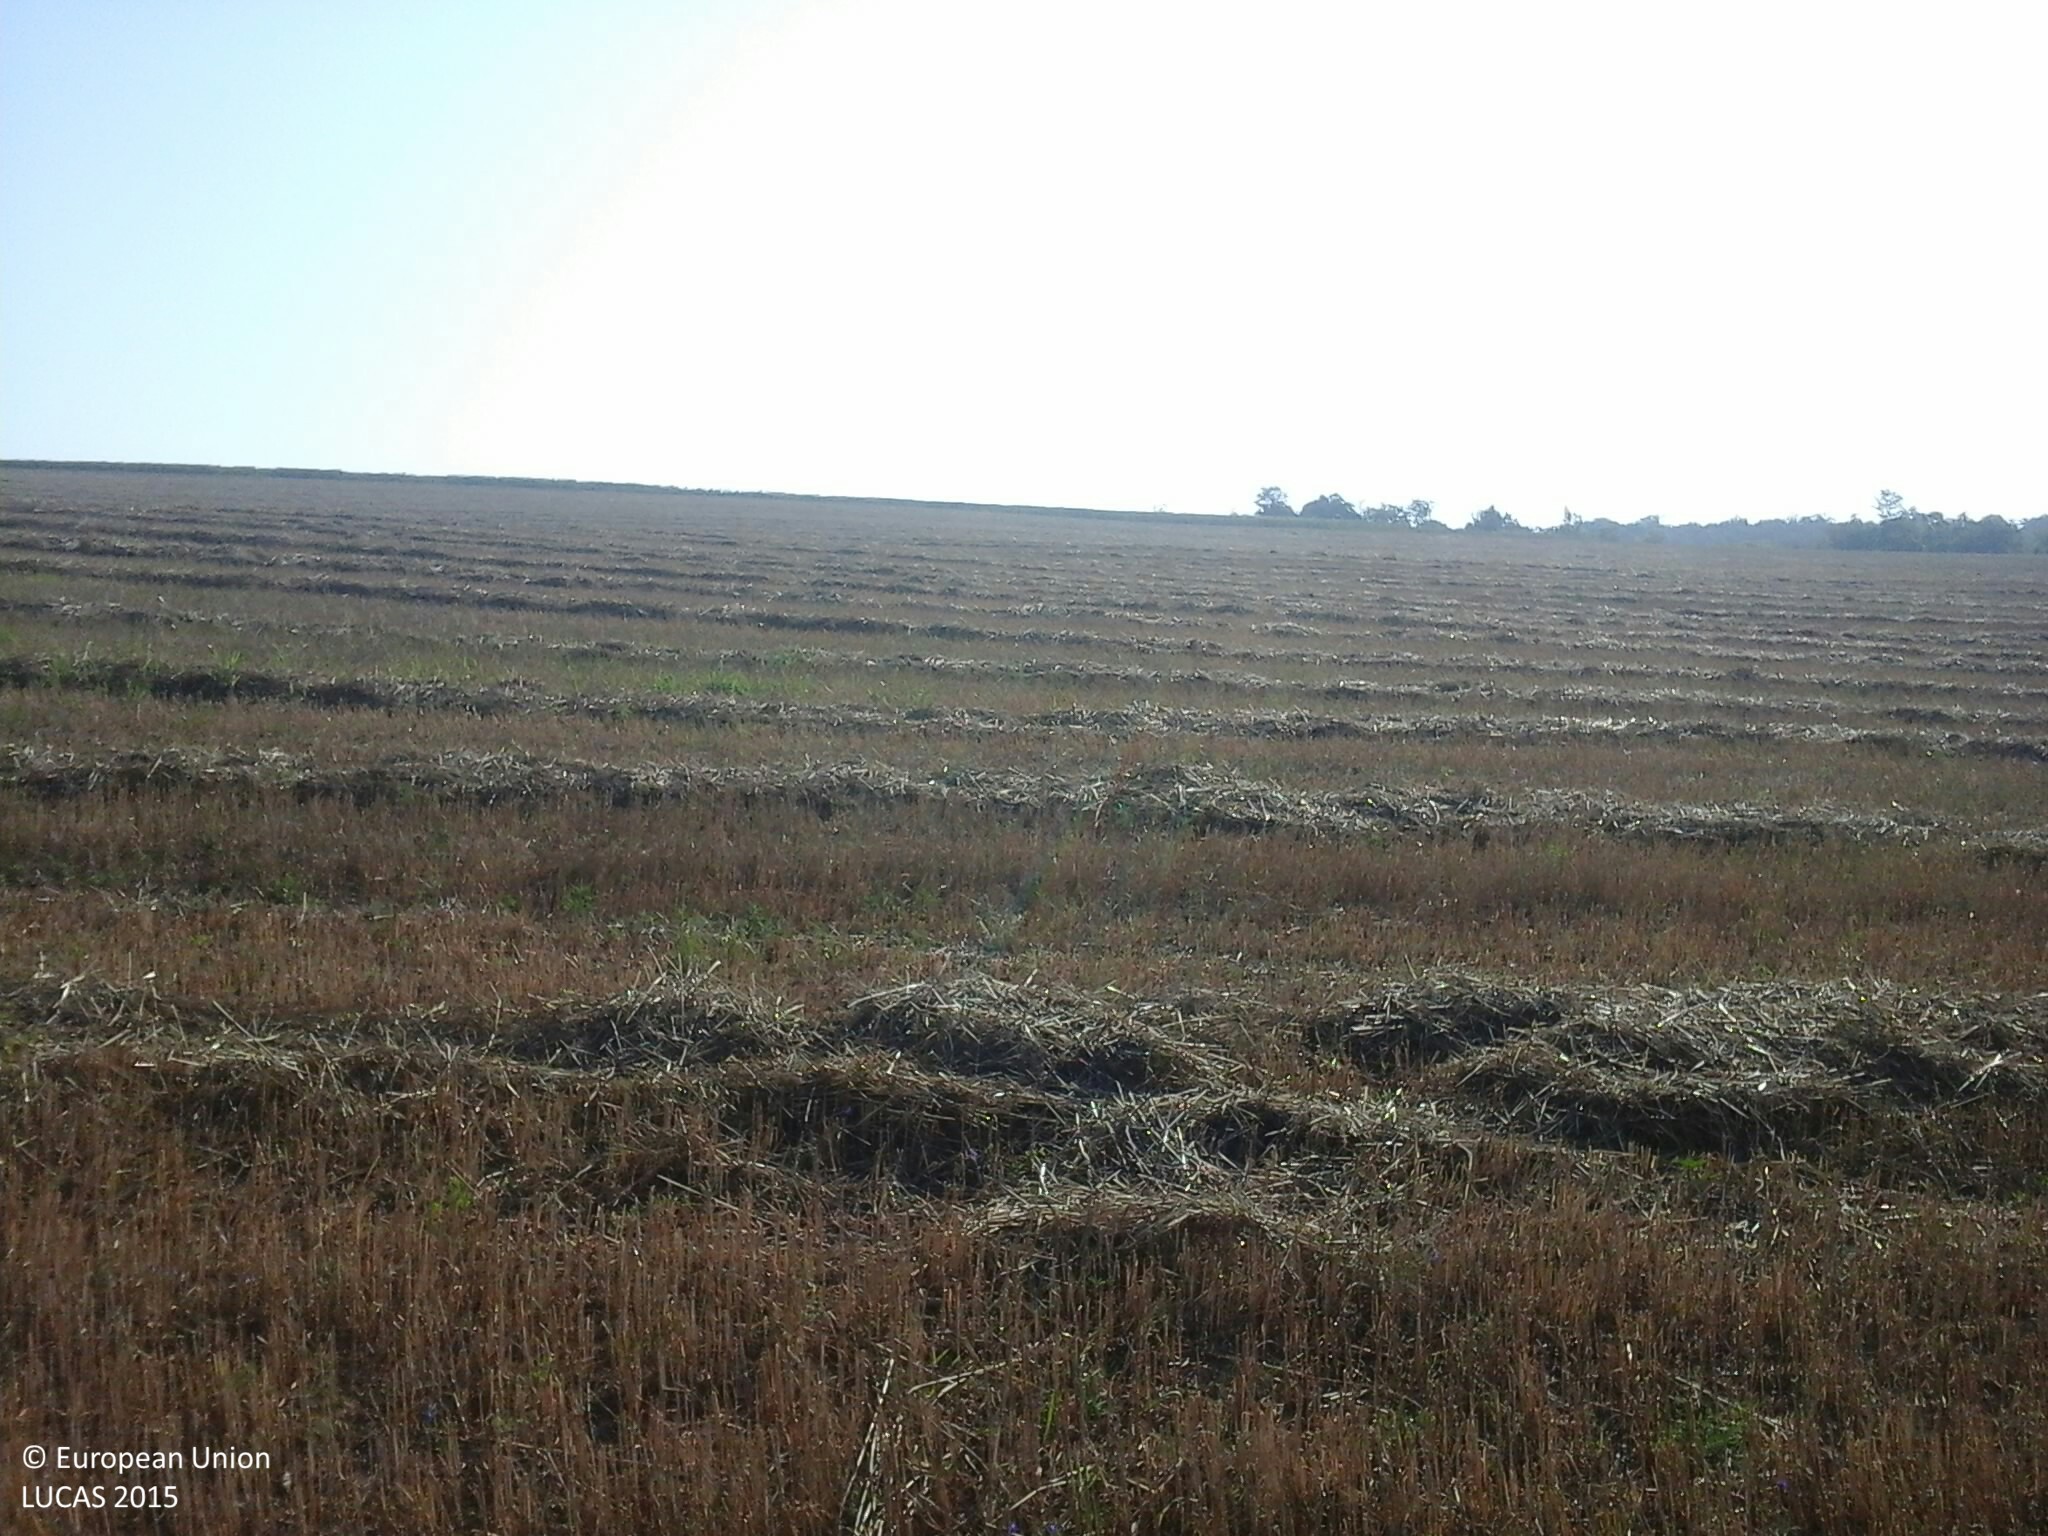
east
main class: Cropland
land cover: Durum wheat
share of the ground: > 75 %
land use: Agriculture (excluding fallow land and kitchen gardens)
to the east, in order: Durum wheat
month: August
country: HU
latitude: 46.7684
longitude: 18.0883
